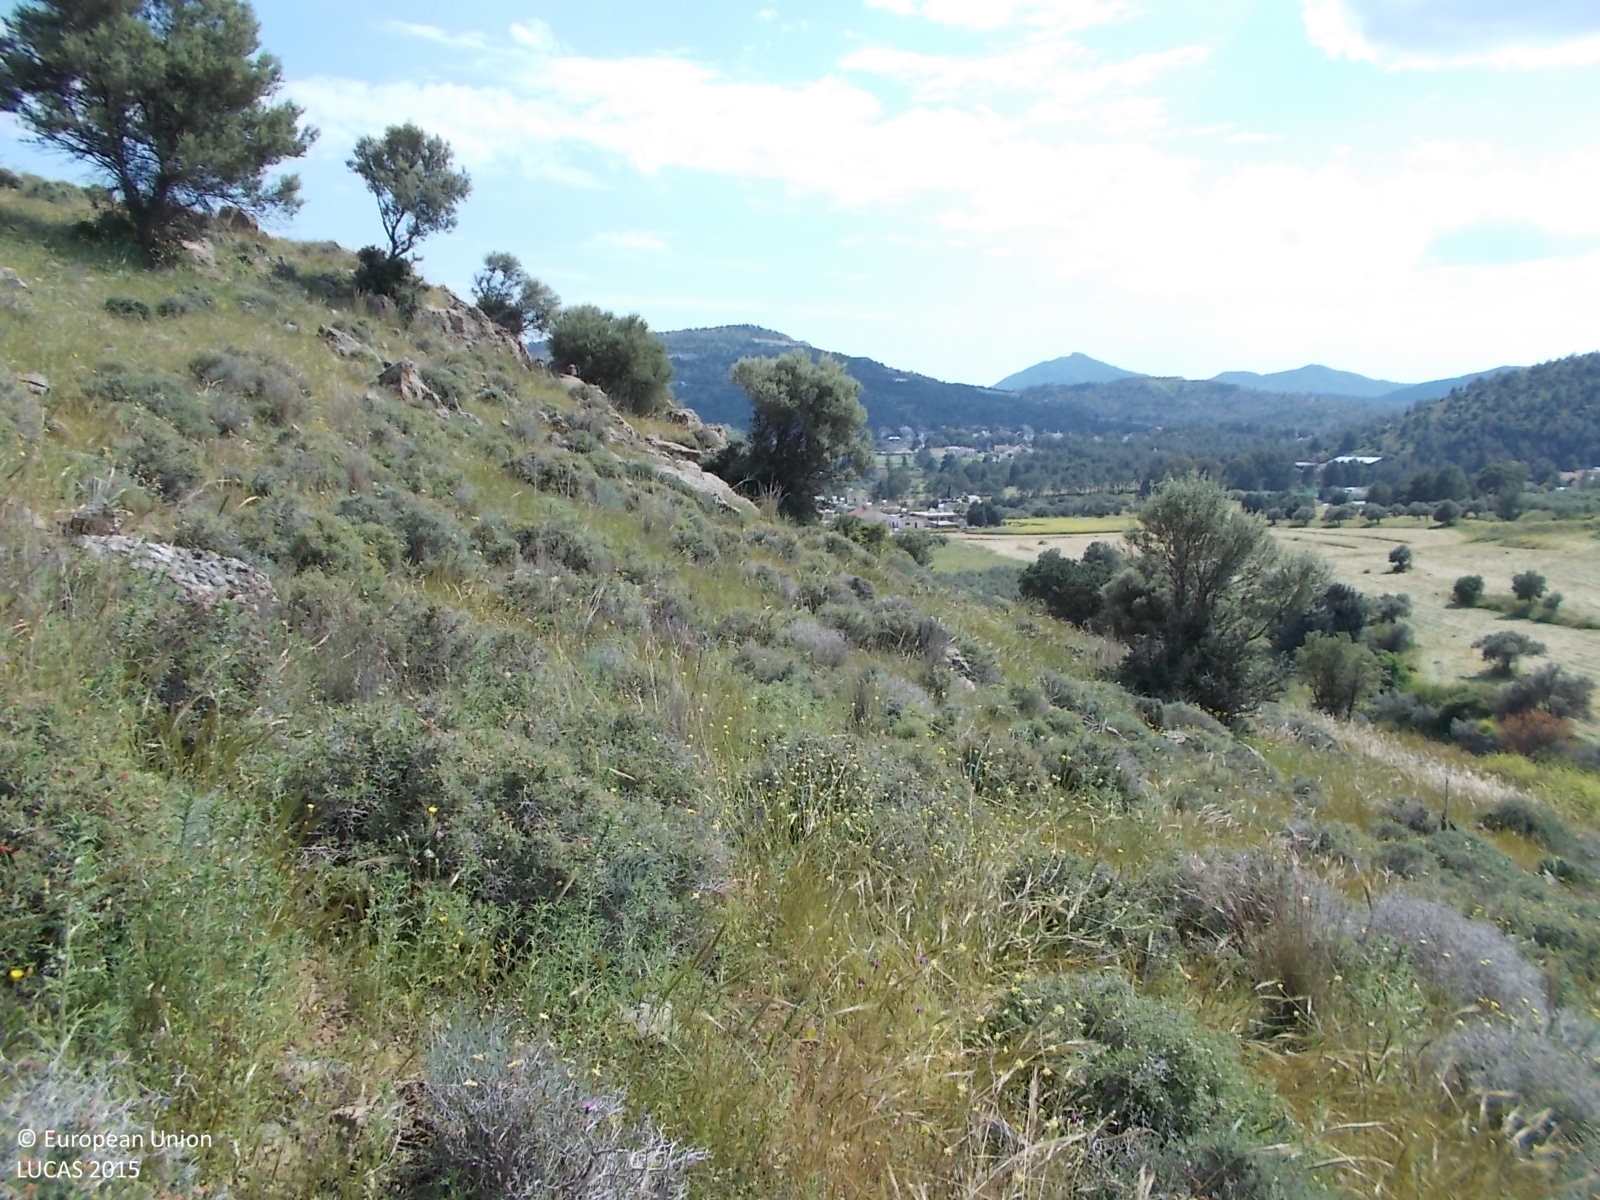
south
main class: Shrubland
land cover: Shrubland without tree cover
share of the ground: > 75 %
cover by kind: shrubs 75 %, herbaceous plants 15 %, unconsolidated bare surface 10 %
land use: Semi-natural and natural areas not in use
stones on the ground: 25 - 50 %
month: April
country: CY
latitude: 34.9562
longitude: 33.4616
